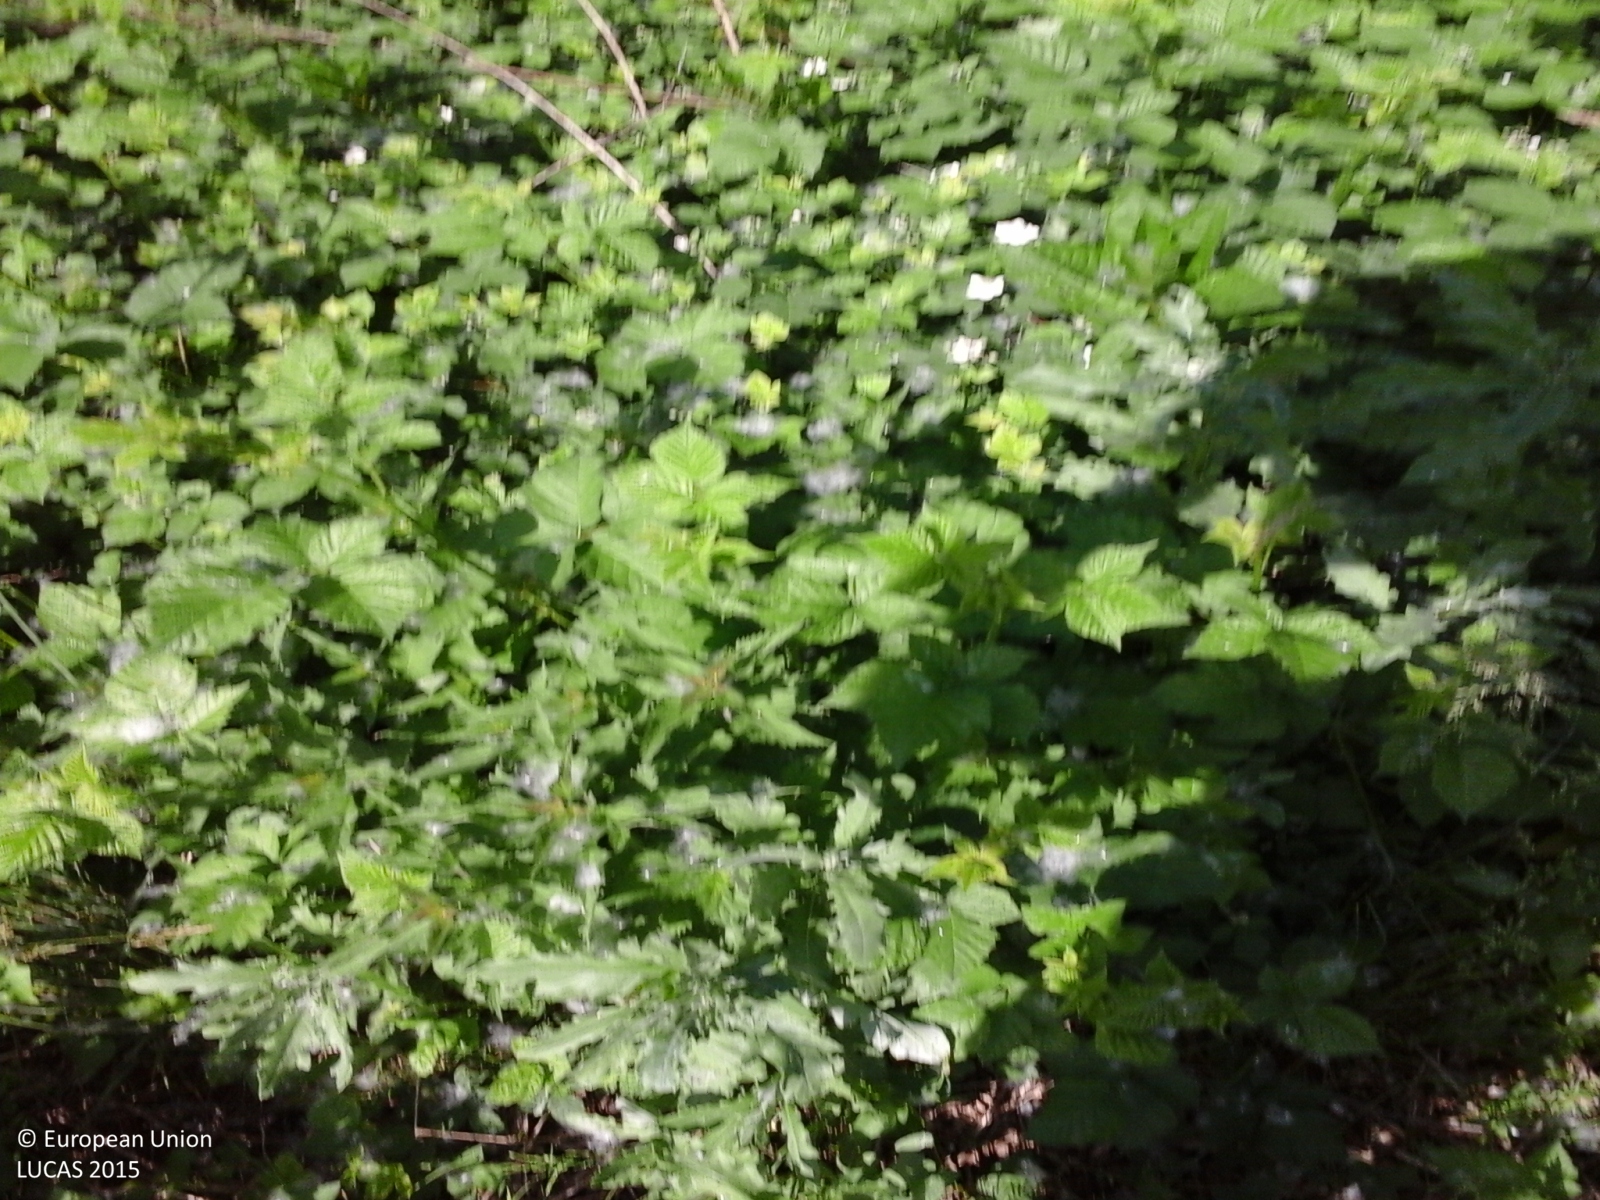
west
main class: Shrubland
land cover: Shrubland with sparse tree cover
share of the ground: > 75 %
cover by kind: shrubs 80 %, herbaceous plants 15 %, broadleaved forest trees 5 %
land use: Fallow land
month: May
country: IT
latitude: 45.5726
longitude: 9.0917
